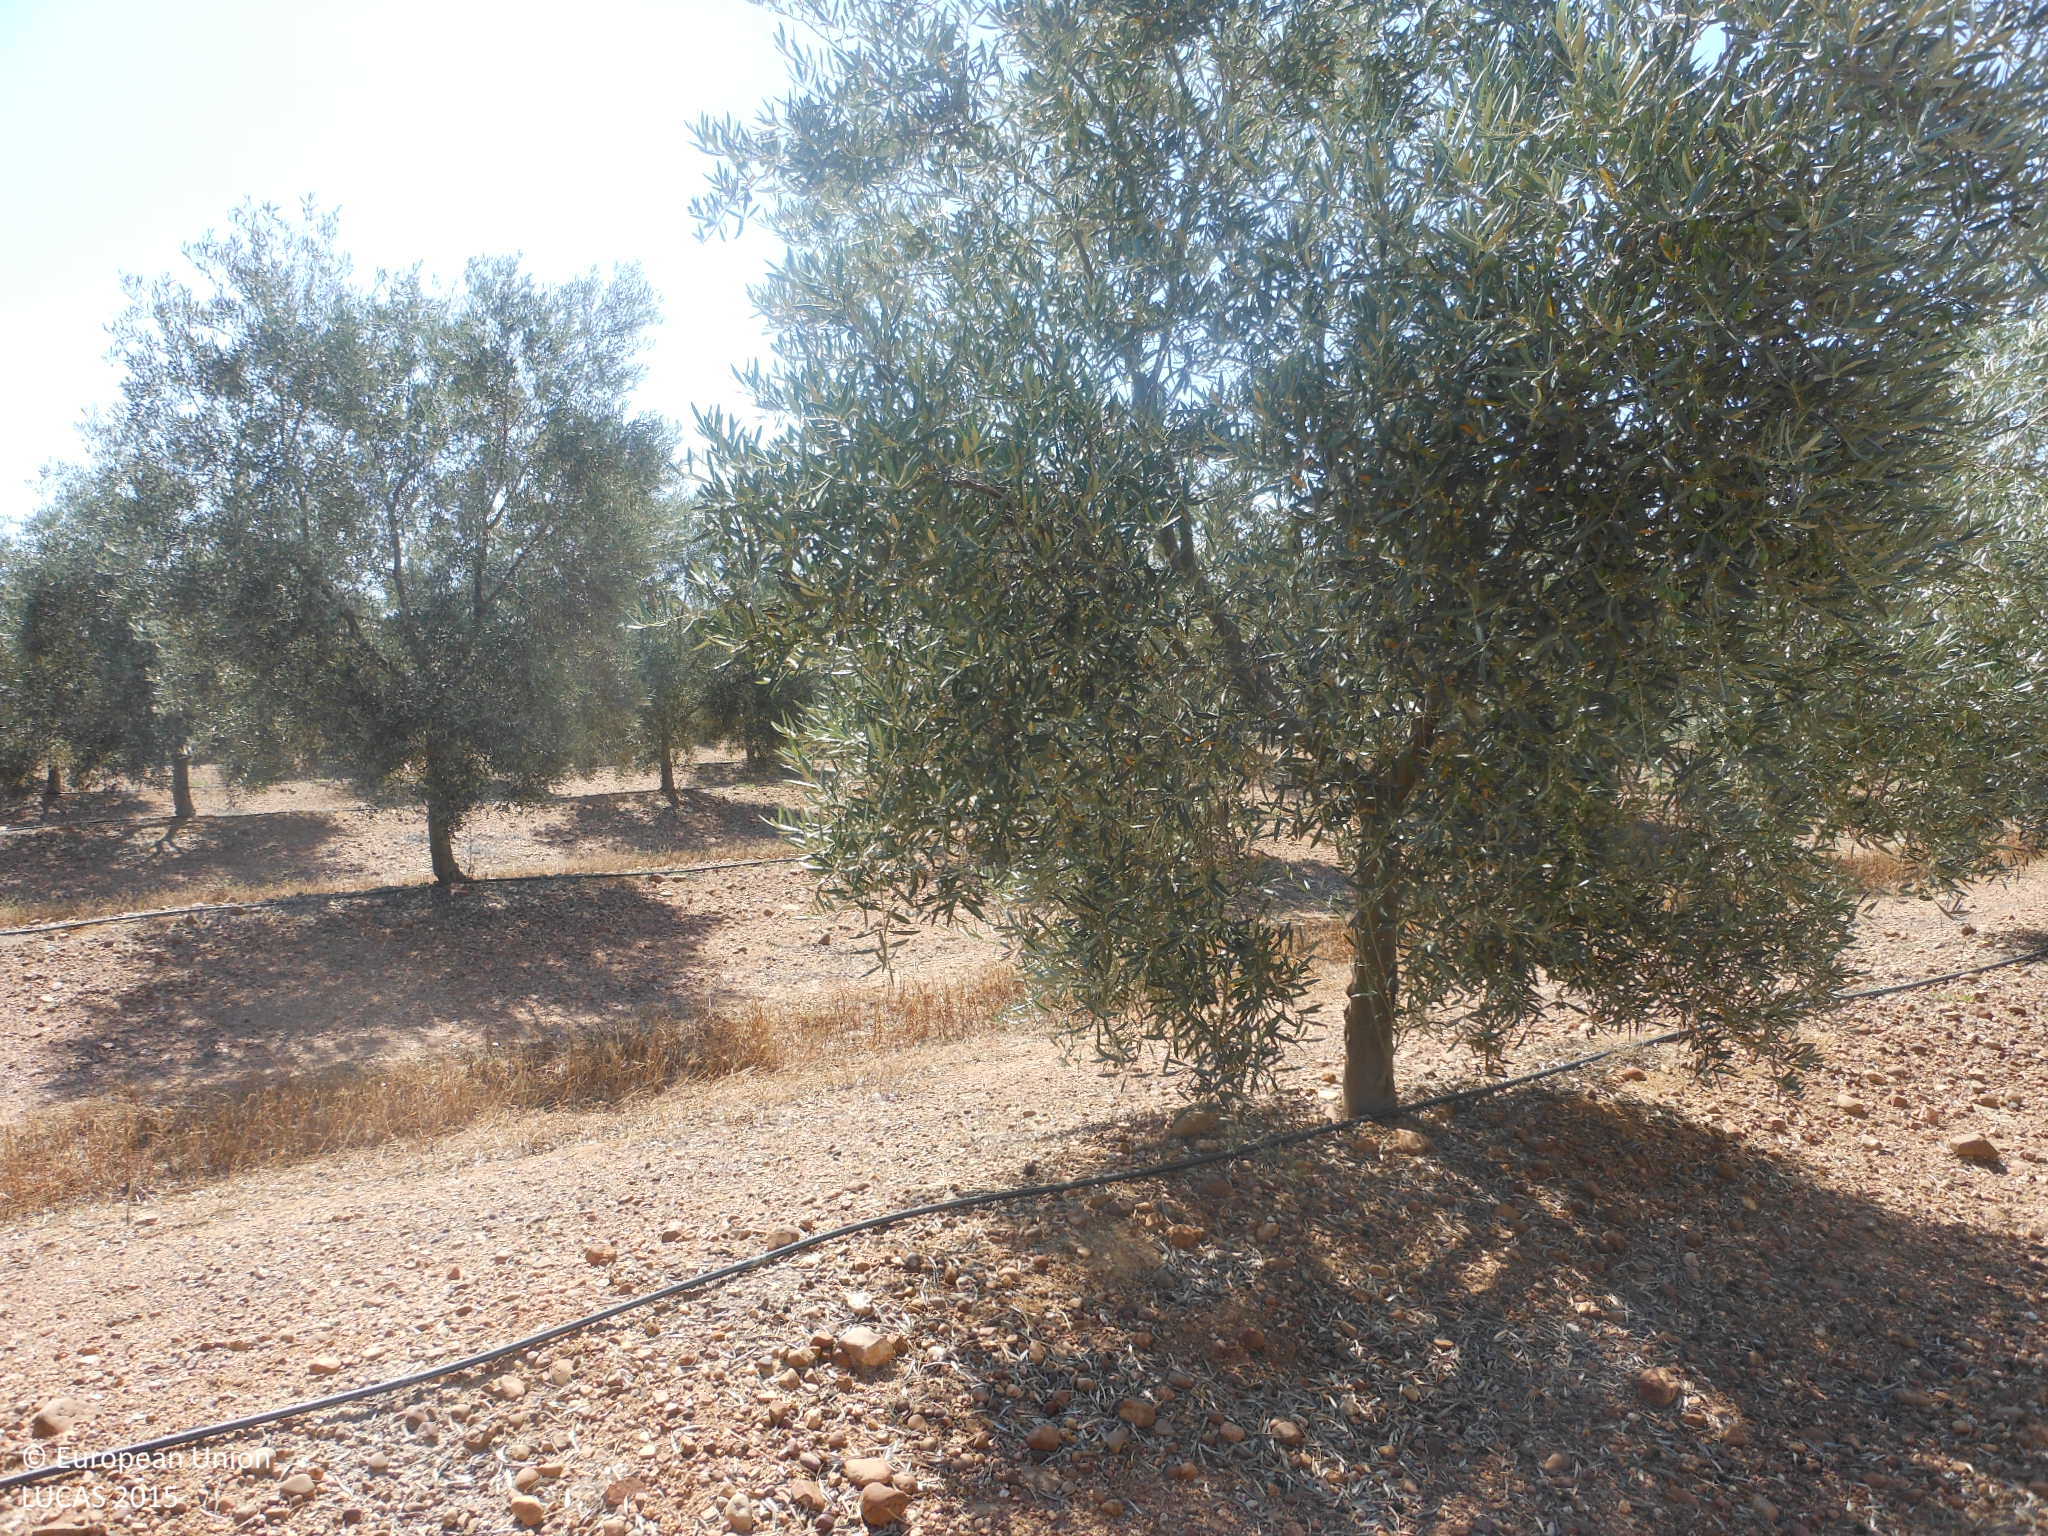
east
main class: Cropland
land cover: Olive groves
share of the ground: 50 - 75 %
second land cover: Spontaneously vegetated surfaces
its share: 10 - 25 %
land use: Agriculture (excluding fallow land and kitchen gardens)
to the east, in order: Olive groves; Spontaneously vegetated surfaces; Tracks; Olive groves
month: June
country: ES
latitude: 37.6709
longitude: -5.1284
